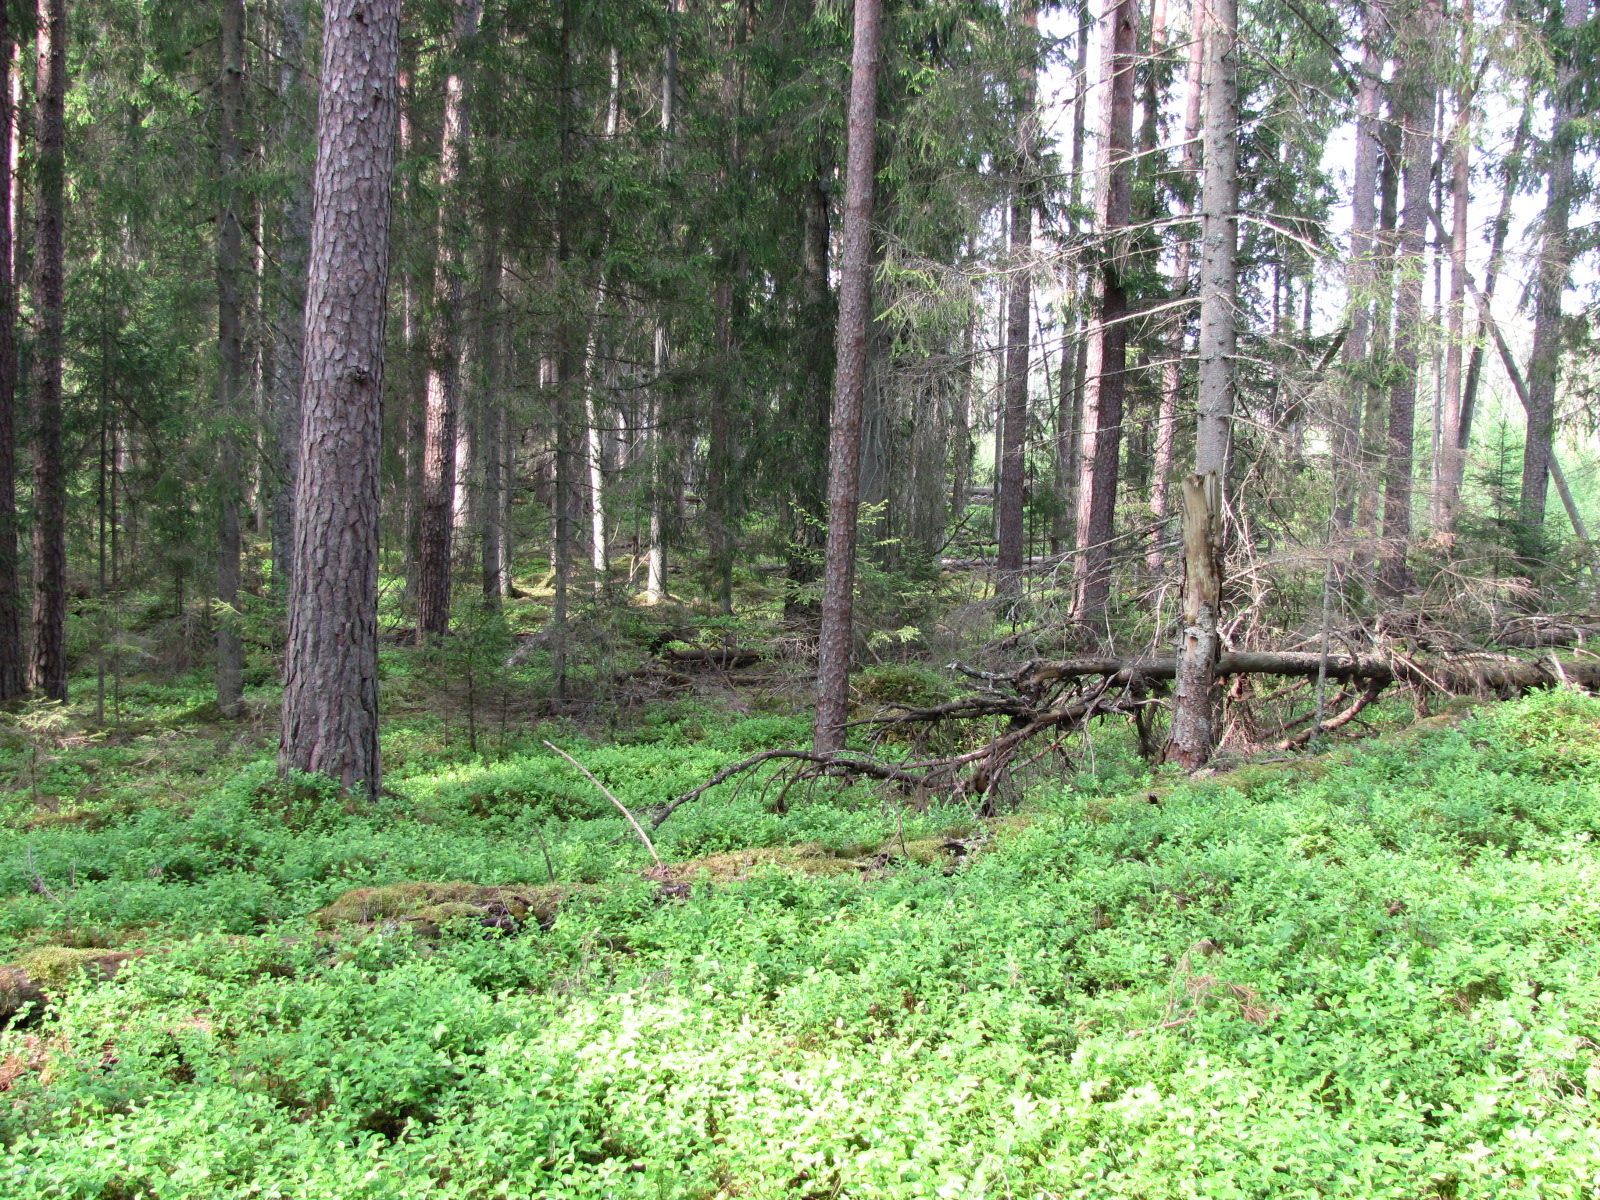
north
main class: Woodland
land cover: Other coniferous woodland
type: hemiboreal forest and nemoral coniferous forest and mixed broadleaved-coniferous forest
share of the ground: > 75 %
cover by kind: coniferous forest trees 90 %, herbaceous plants 5 %, lichens and mosses 5 %
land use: Forestry
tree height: > 5 m
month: June
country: LV
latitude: 56.6371
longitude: 24.3584
